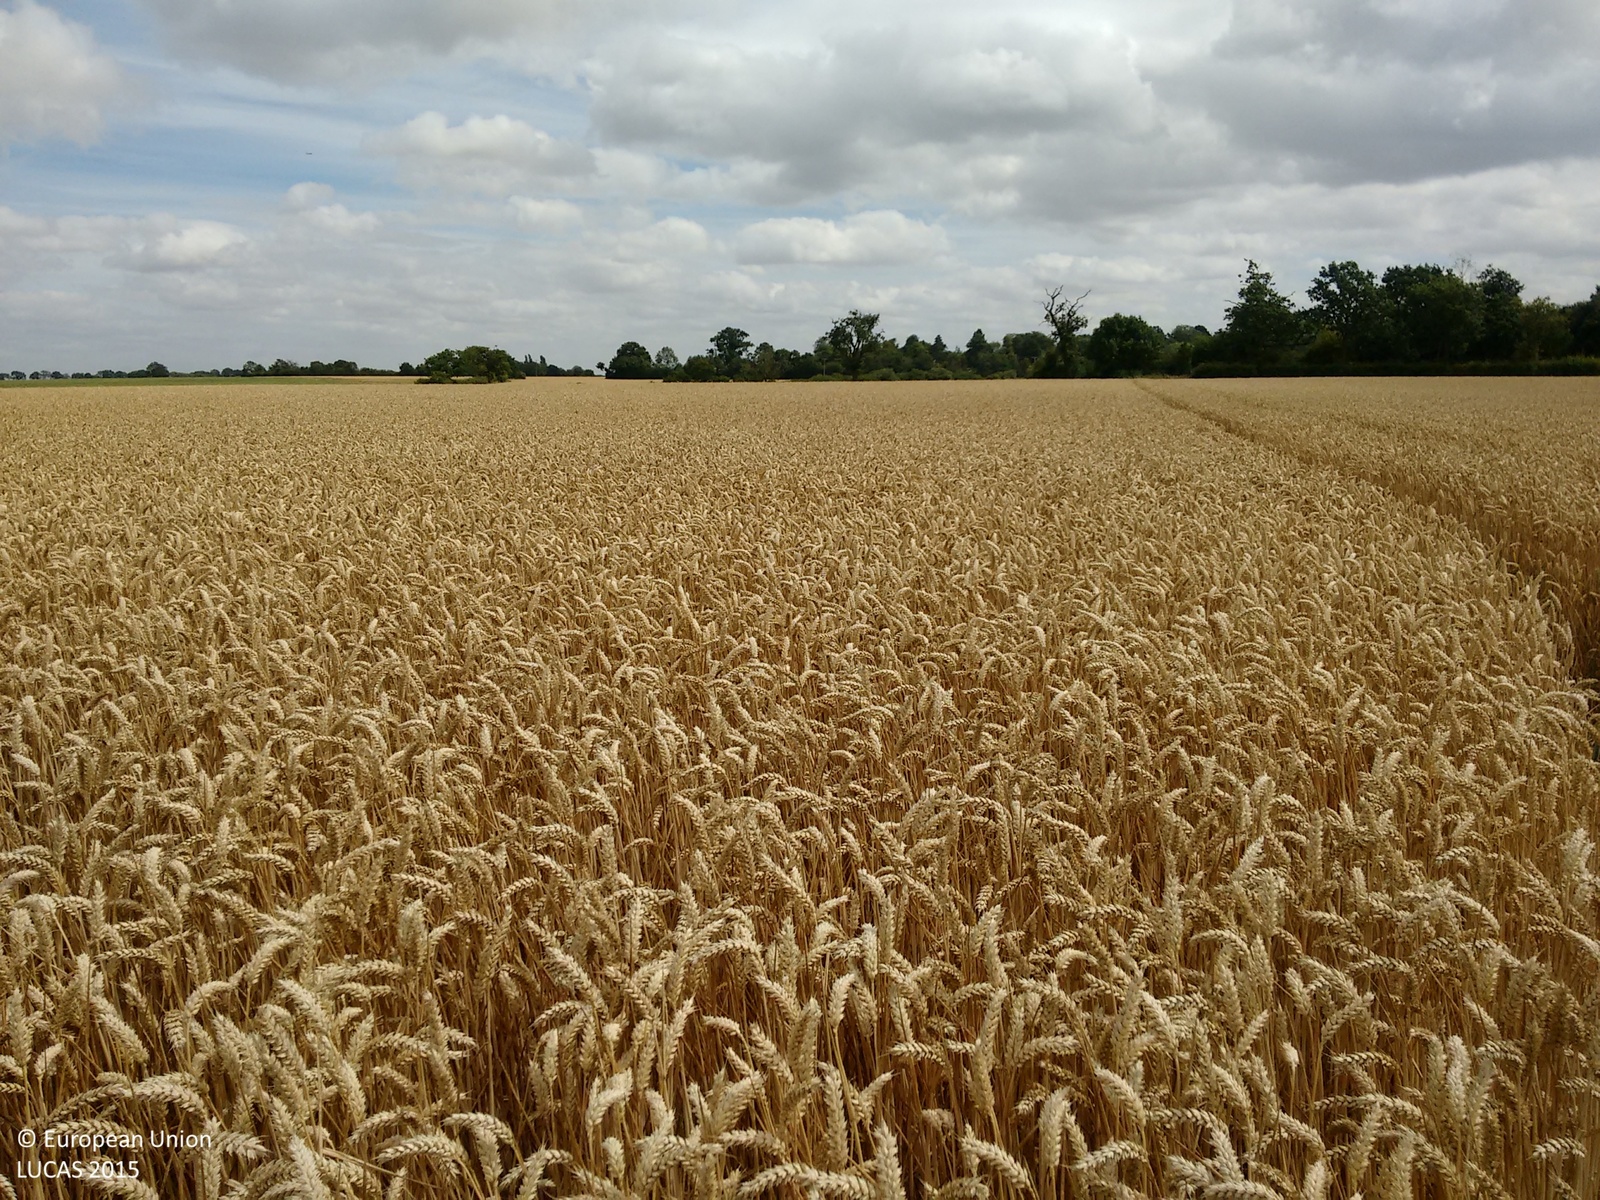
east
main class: Cropland
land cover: Common wheat
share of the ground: > 75 %
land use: Agriculture (excluding fallow land and kitchen gardens)
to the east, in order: Common wheat; Grass margins; Ditches and canals; Grass margins; Tracks; Abandoned hedges; Ditches and canals; Grass margins; Common wheat
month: August
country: GB
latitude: 51.9832
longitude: 0.3464
